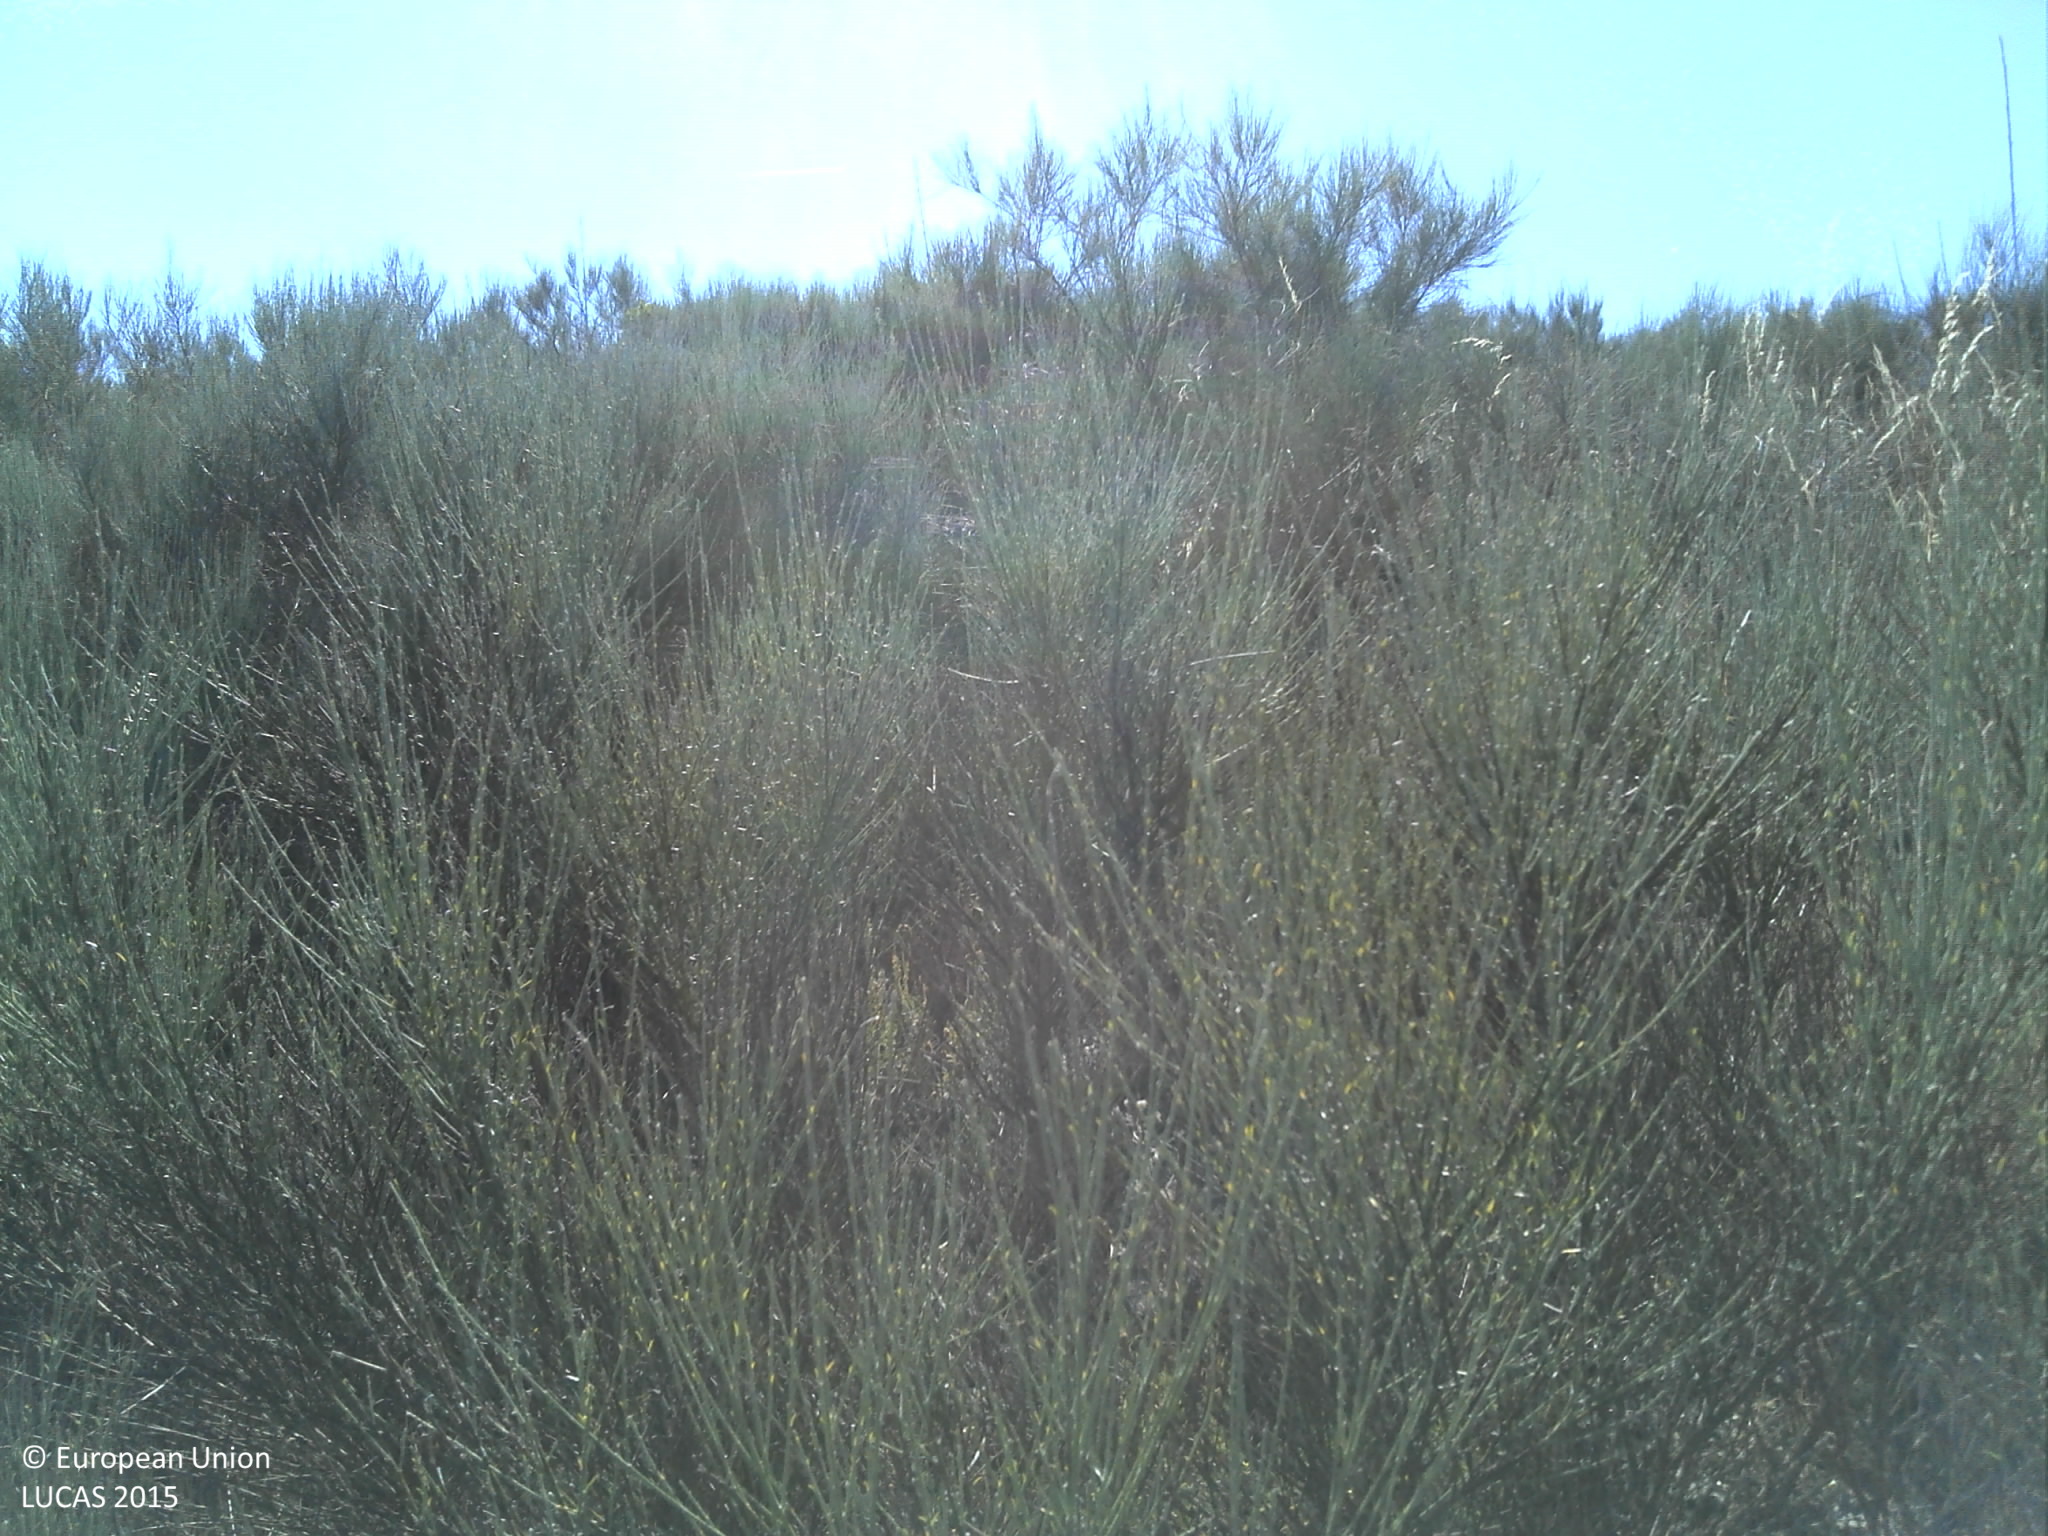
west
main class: Shrubland
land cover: Shrubland without tree cover
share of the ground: > 75 %
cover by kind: shrubs 95 %, herbaceous plants 5 %
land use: Semi-natural and natural areas not in use
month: June
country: PT
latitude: 40.9977
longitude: -7.0241
